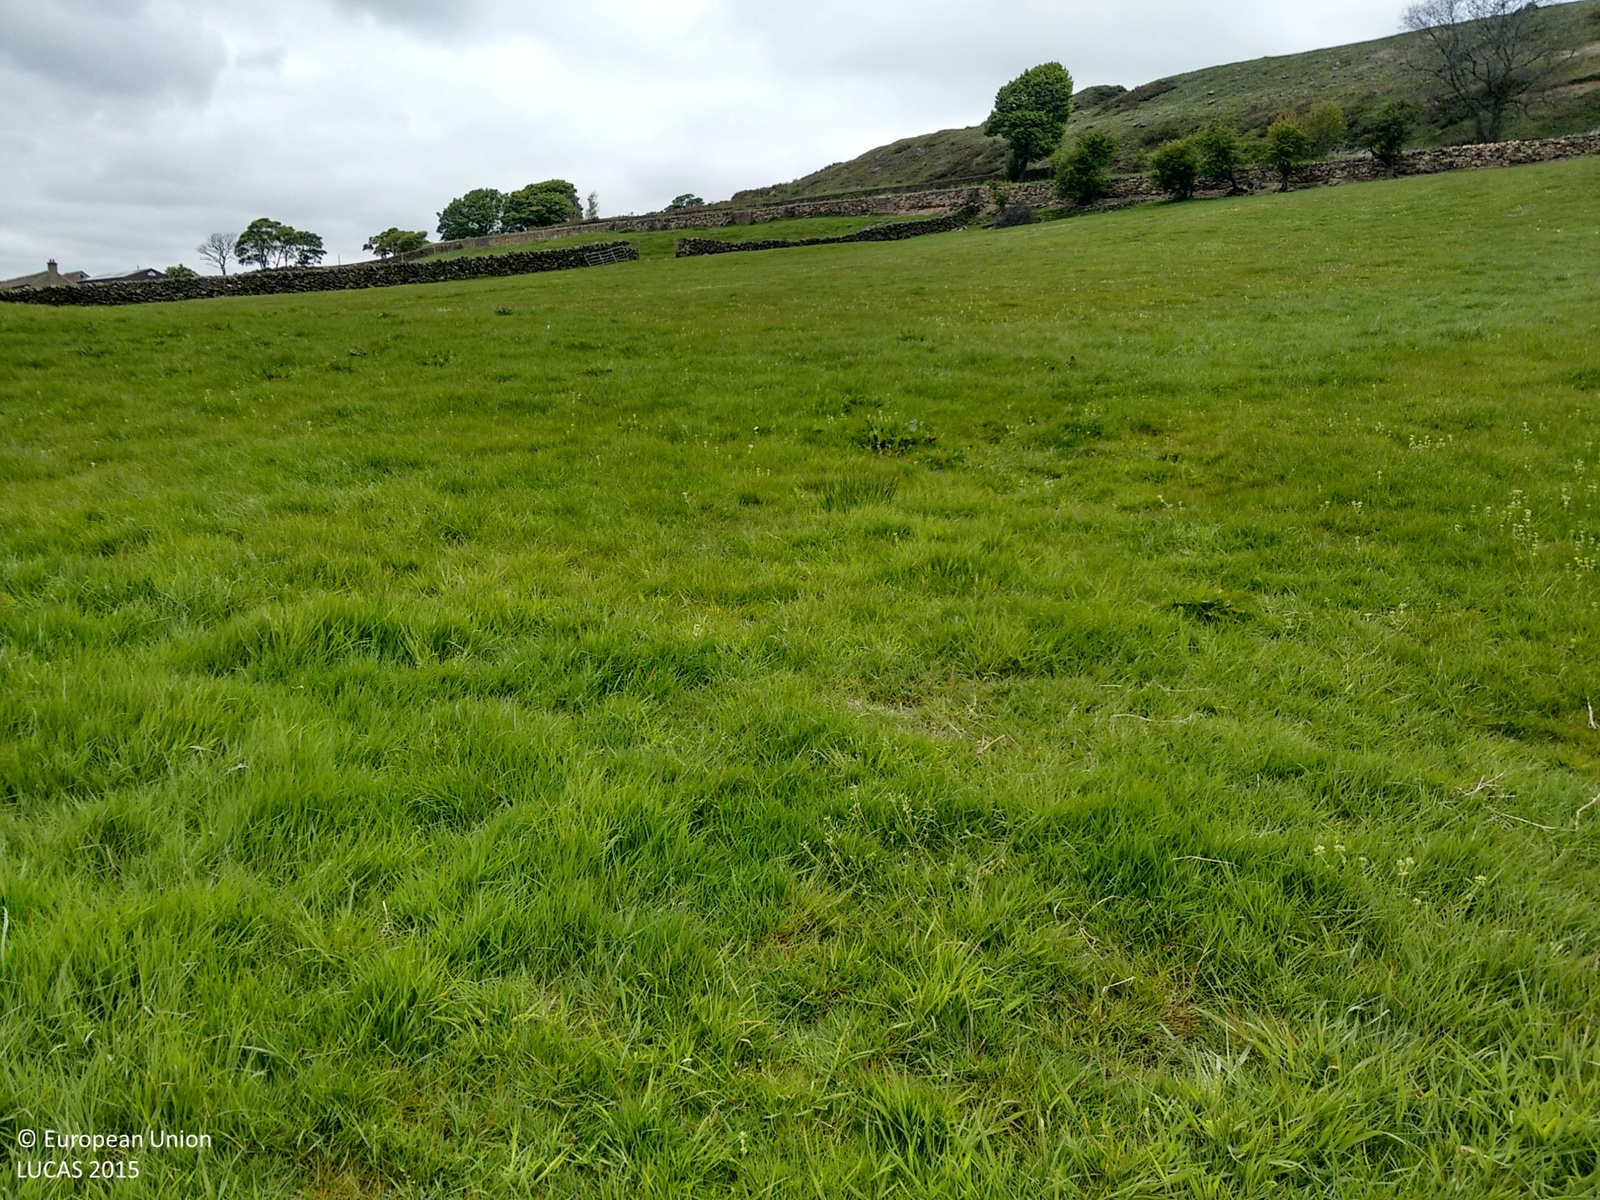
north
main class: Grassland
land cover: Grassland without tree/shrub cover
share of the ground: > 75 %
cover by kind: herbaceous plants 100 %
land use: Agriculture (excluding fallow land and kitchen gardens)
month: May
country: GB
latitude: 53.4243
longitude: -1.5938
